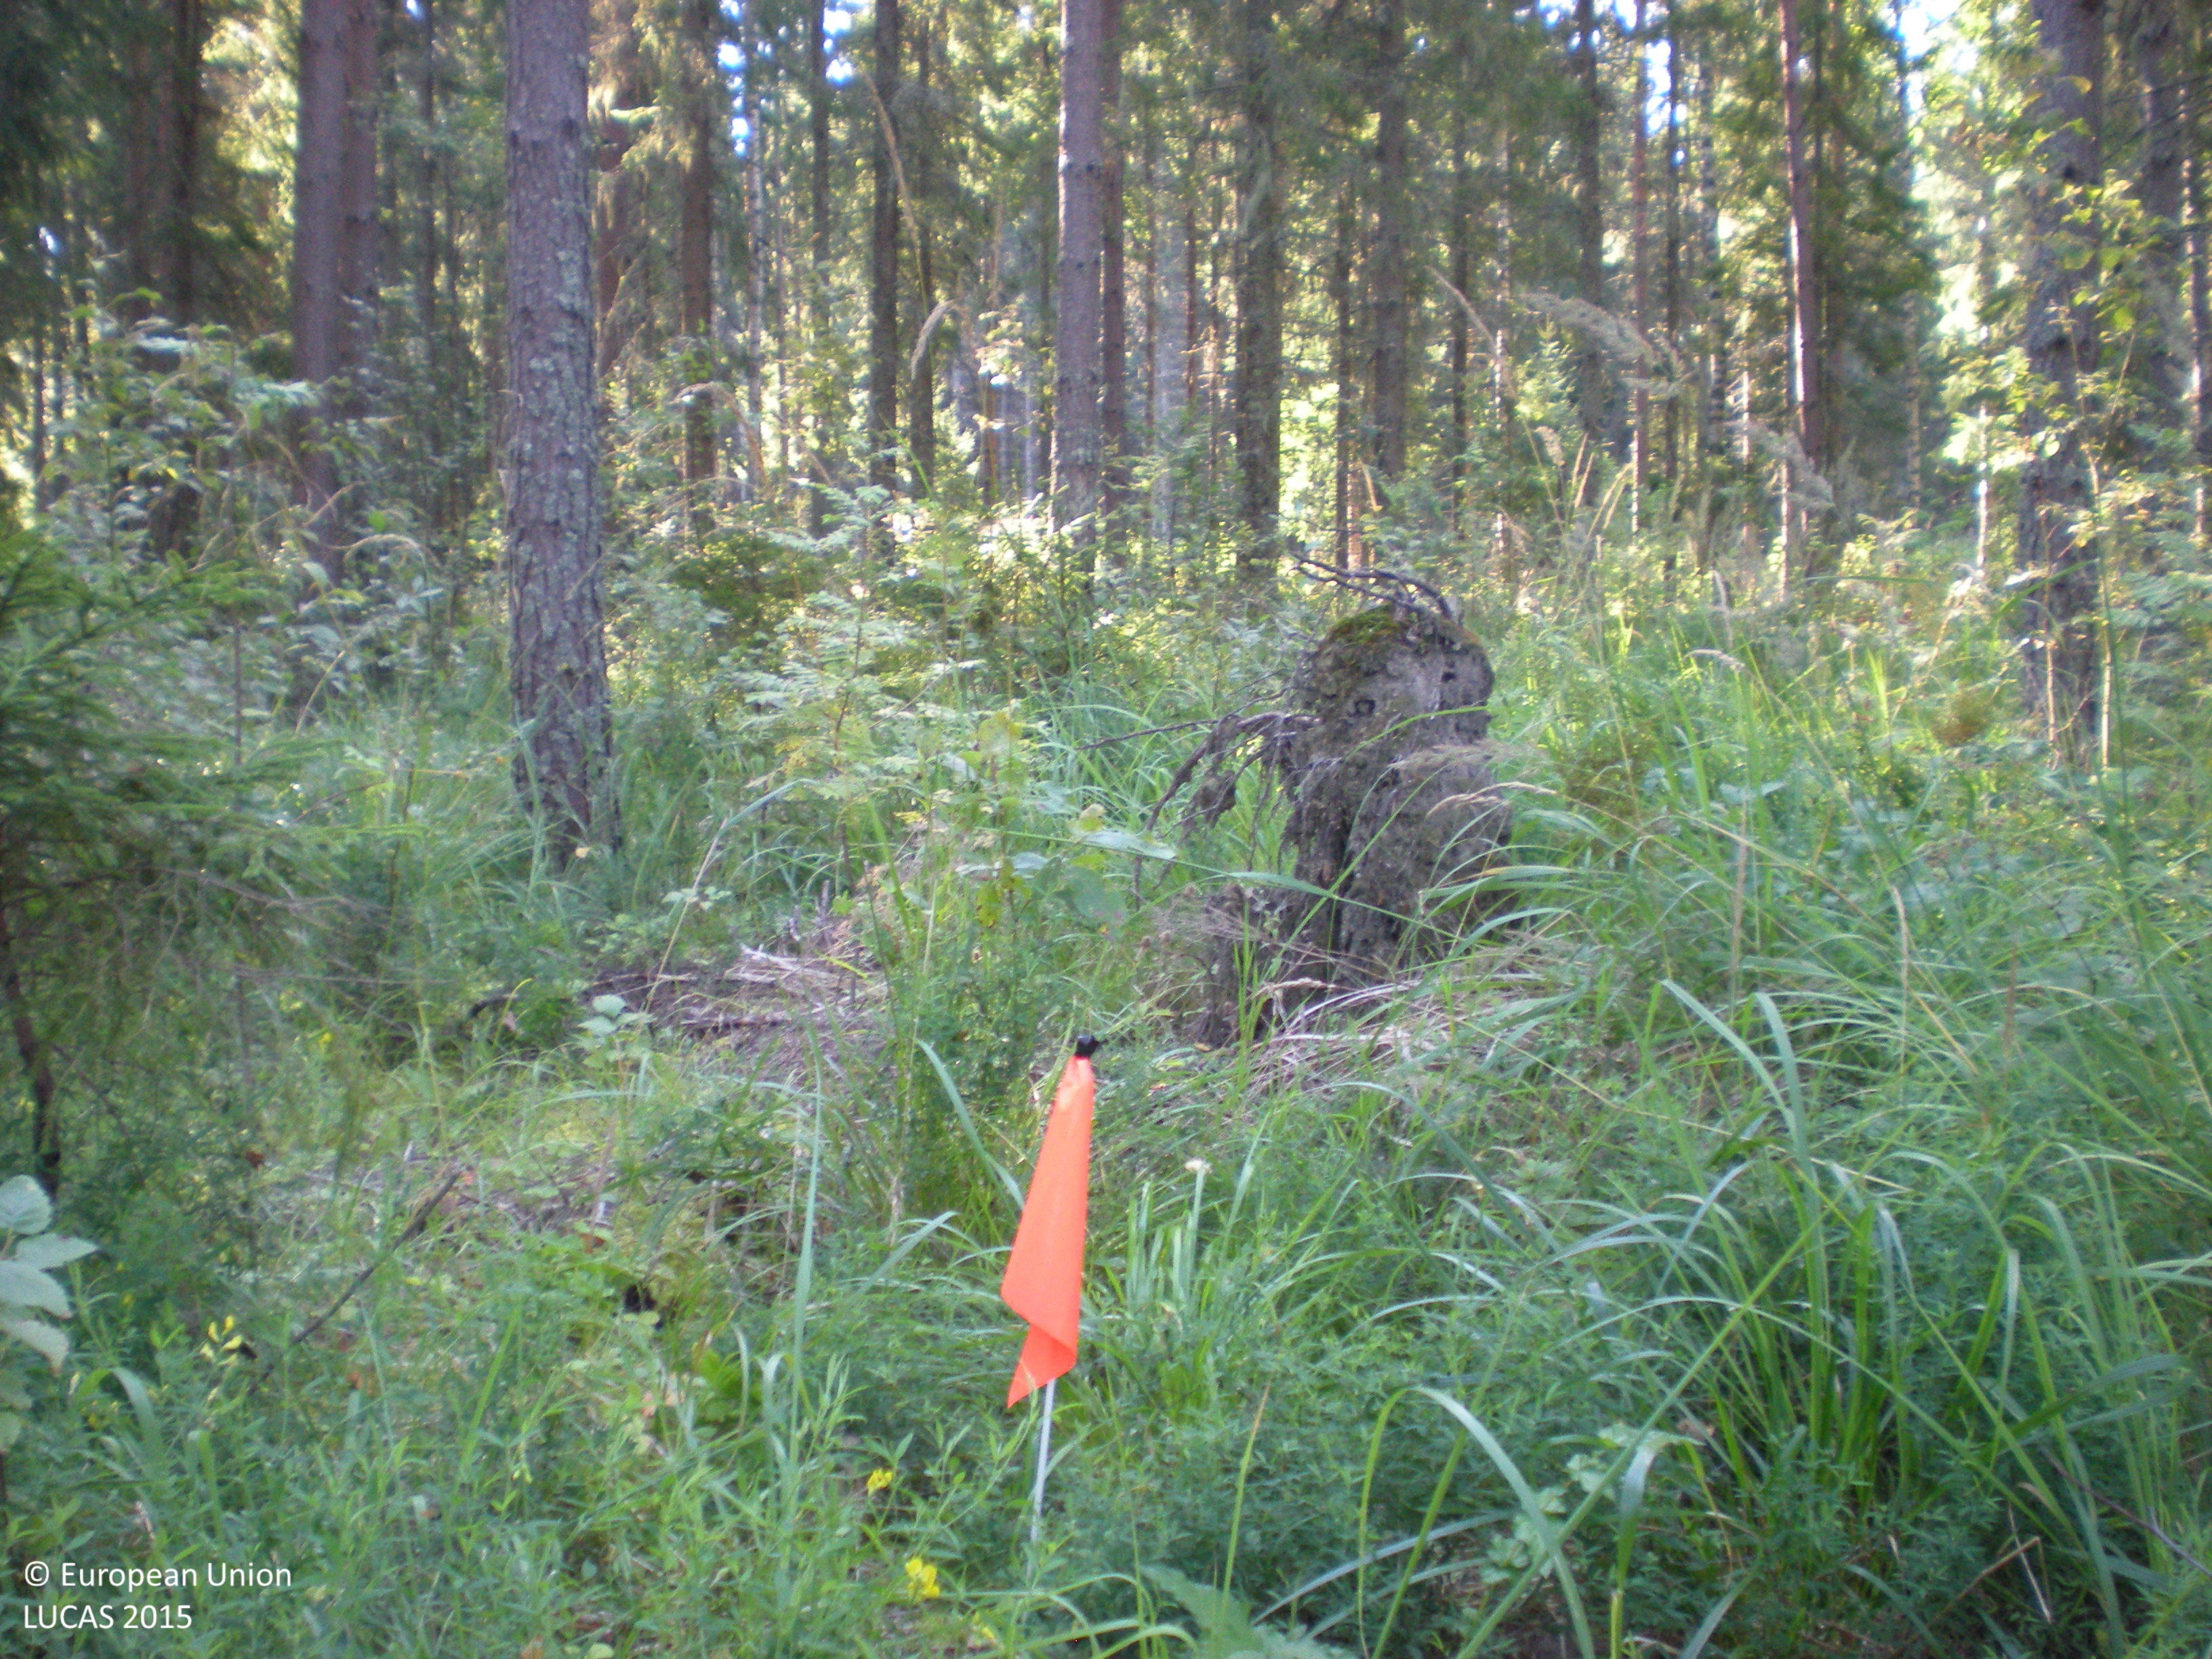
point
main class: Woodland
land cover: Other coniferous woodland
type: boreal forest
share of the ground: 50 - 75 %
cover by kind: coniferous forest trees 65 %, herbaceous plants 15 %, lichens and mosses 10 %, broadleaved forest trees 5 %, shrubs 5 %
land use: Forestry
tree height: > 5 m
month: August
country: SE
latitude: 60.3875
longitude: 17.3387
